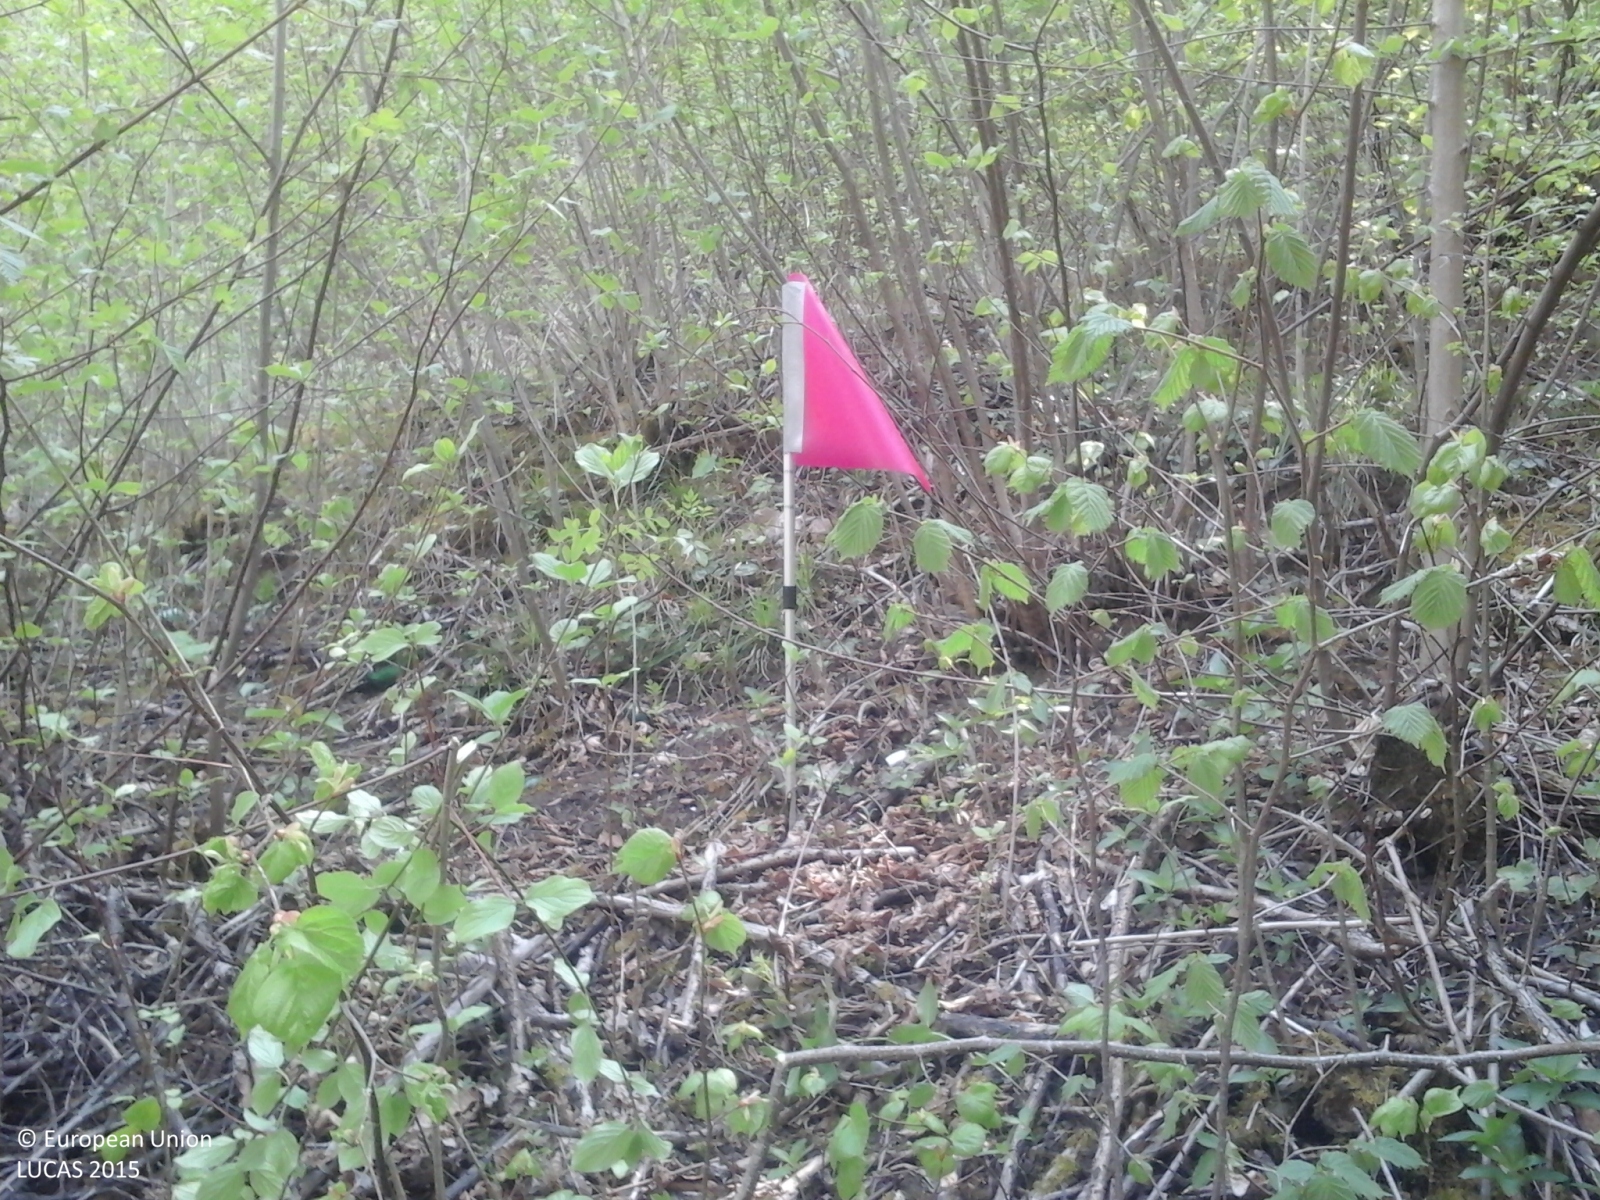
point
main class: Woodland
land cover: Broadleaved woodland
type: thermophilous deciduous forest
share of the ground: > 75 %
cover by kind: broadleaved forest trees 90 %, coniferous forest trees 10 %
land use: Forestry
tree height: > 5 m
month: April
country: IT
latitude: 46.3638
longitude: 11.0774
